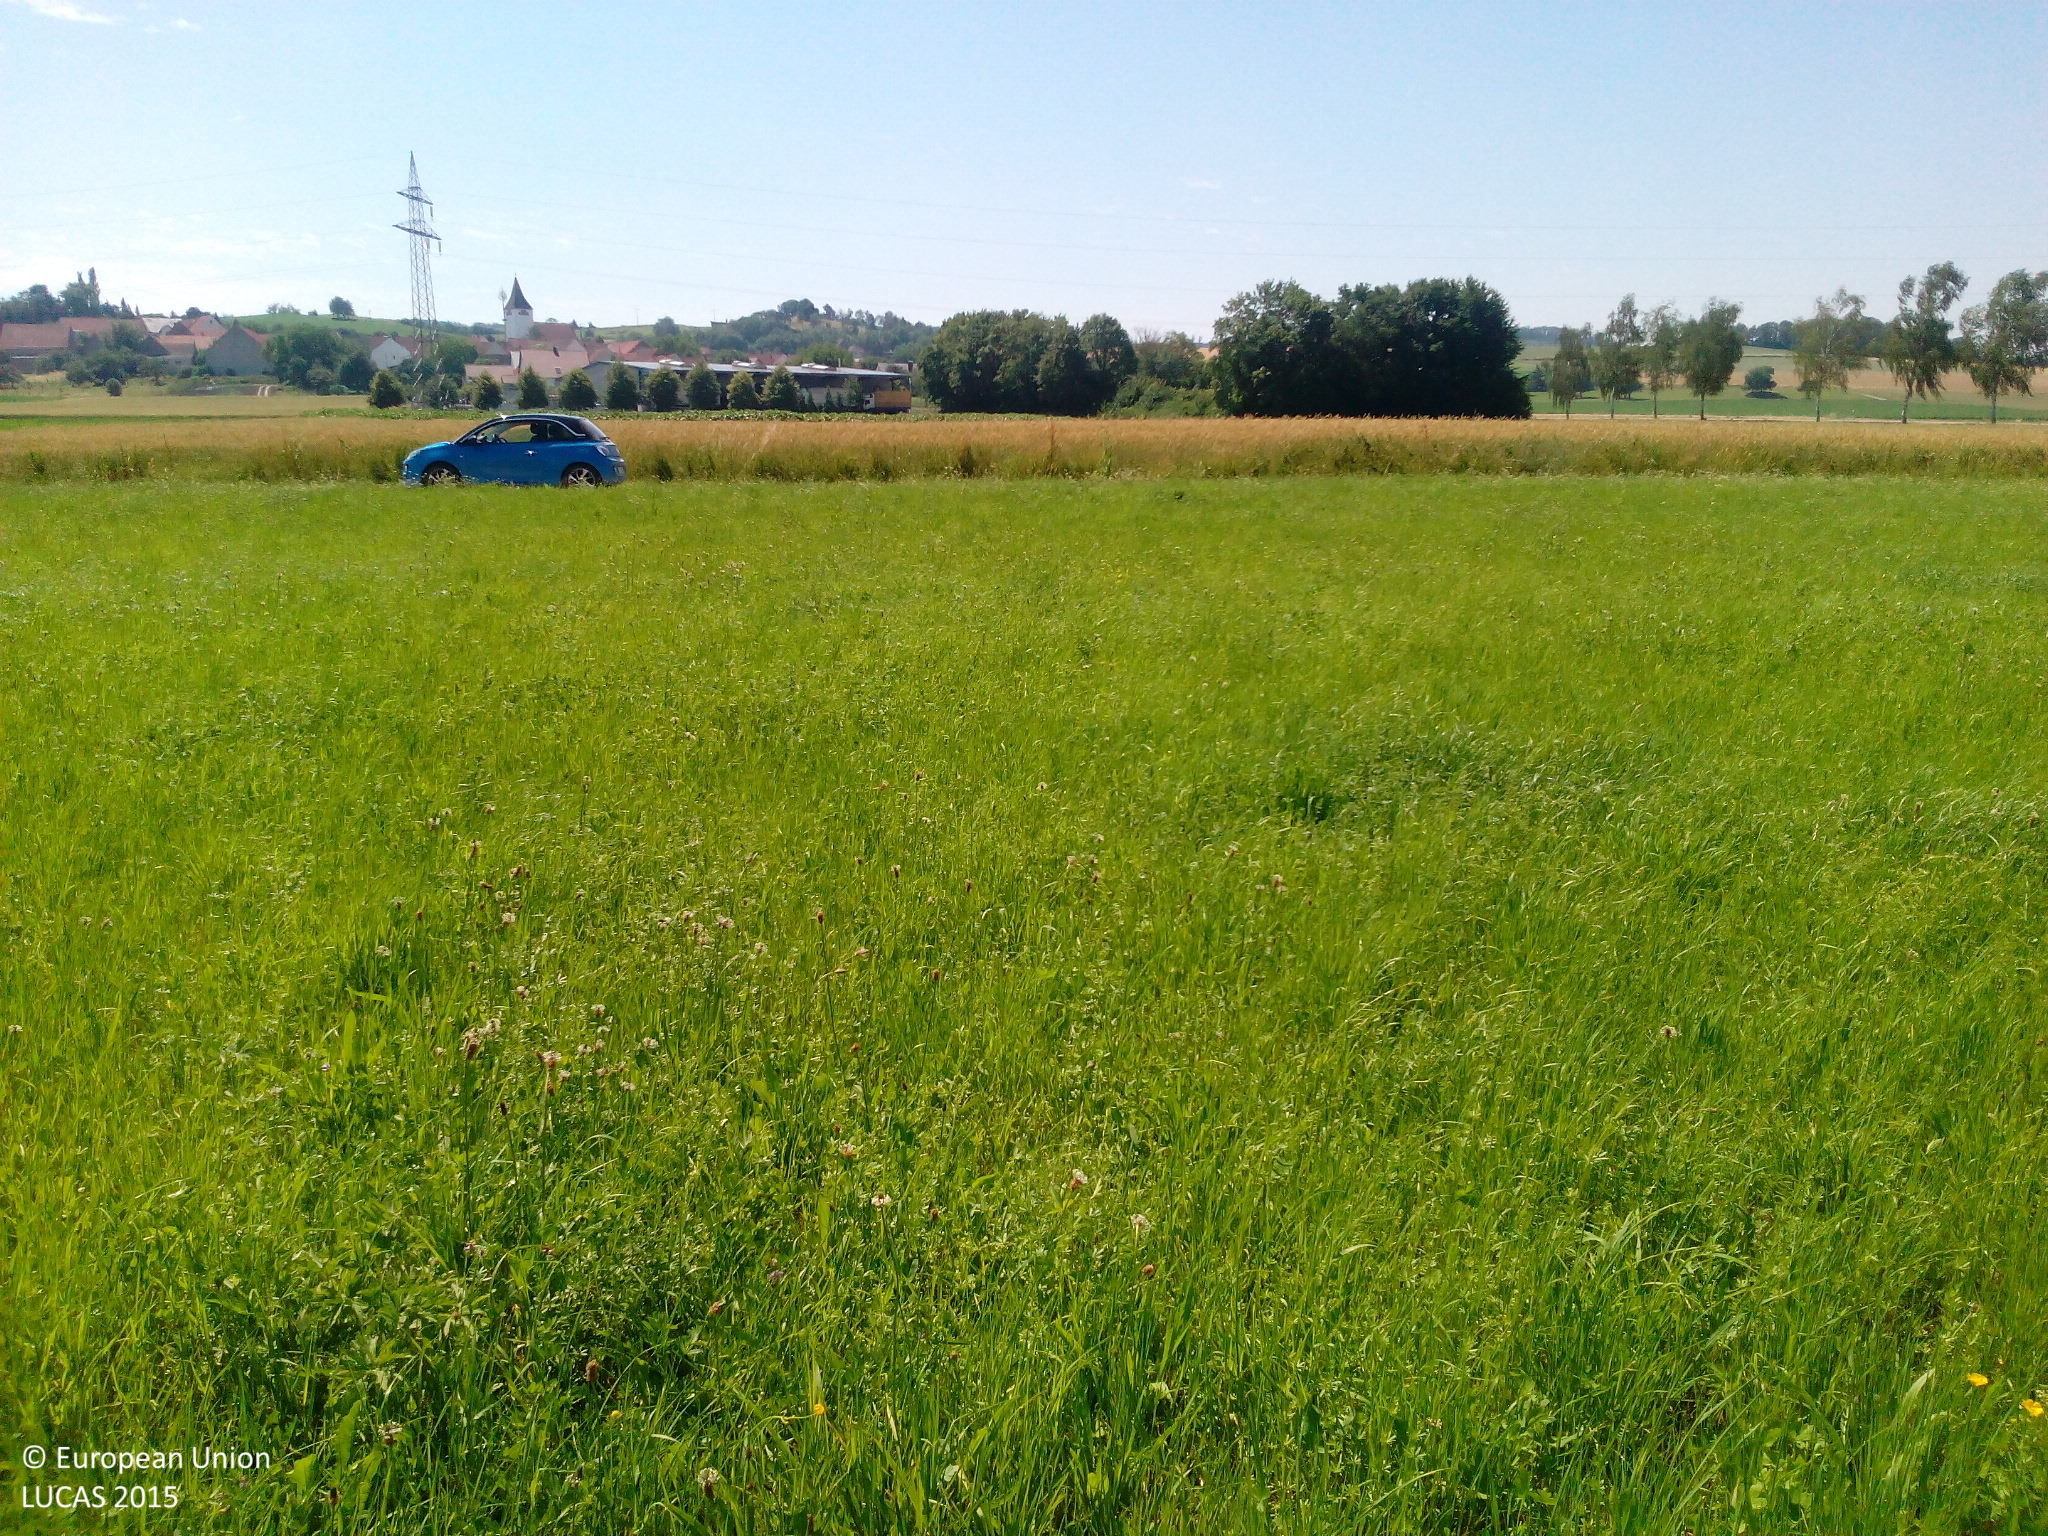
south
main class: Grassland
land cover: Grassland without tree/shrub cover
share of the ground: > 75 %
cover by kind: herbaceous plants 90 %, unconsolidated bare surface 10 %
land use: Agriculture (excluding fallow land and kitchen gardens)
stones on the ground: < 10 %
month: July
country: DE
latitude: 48.7975
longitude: 10.6395
